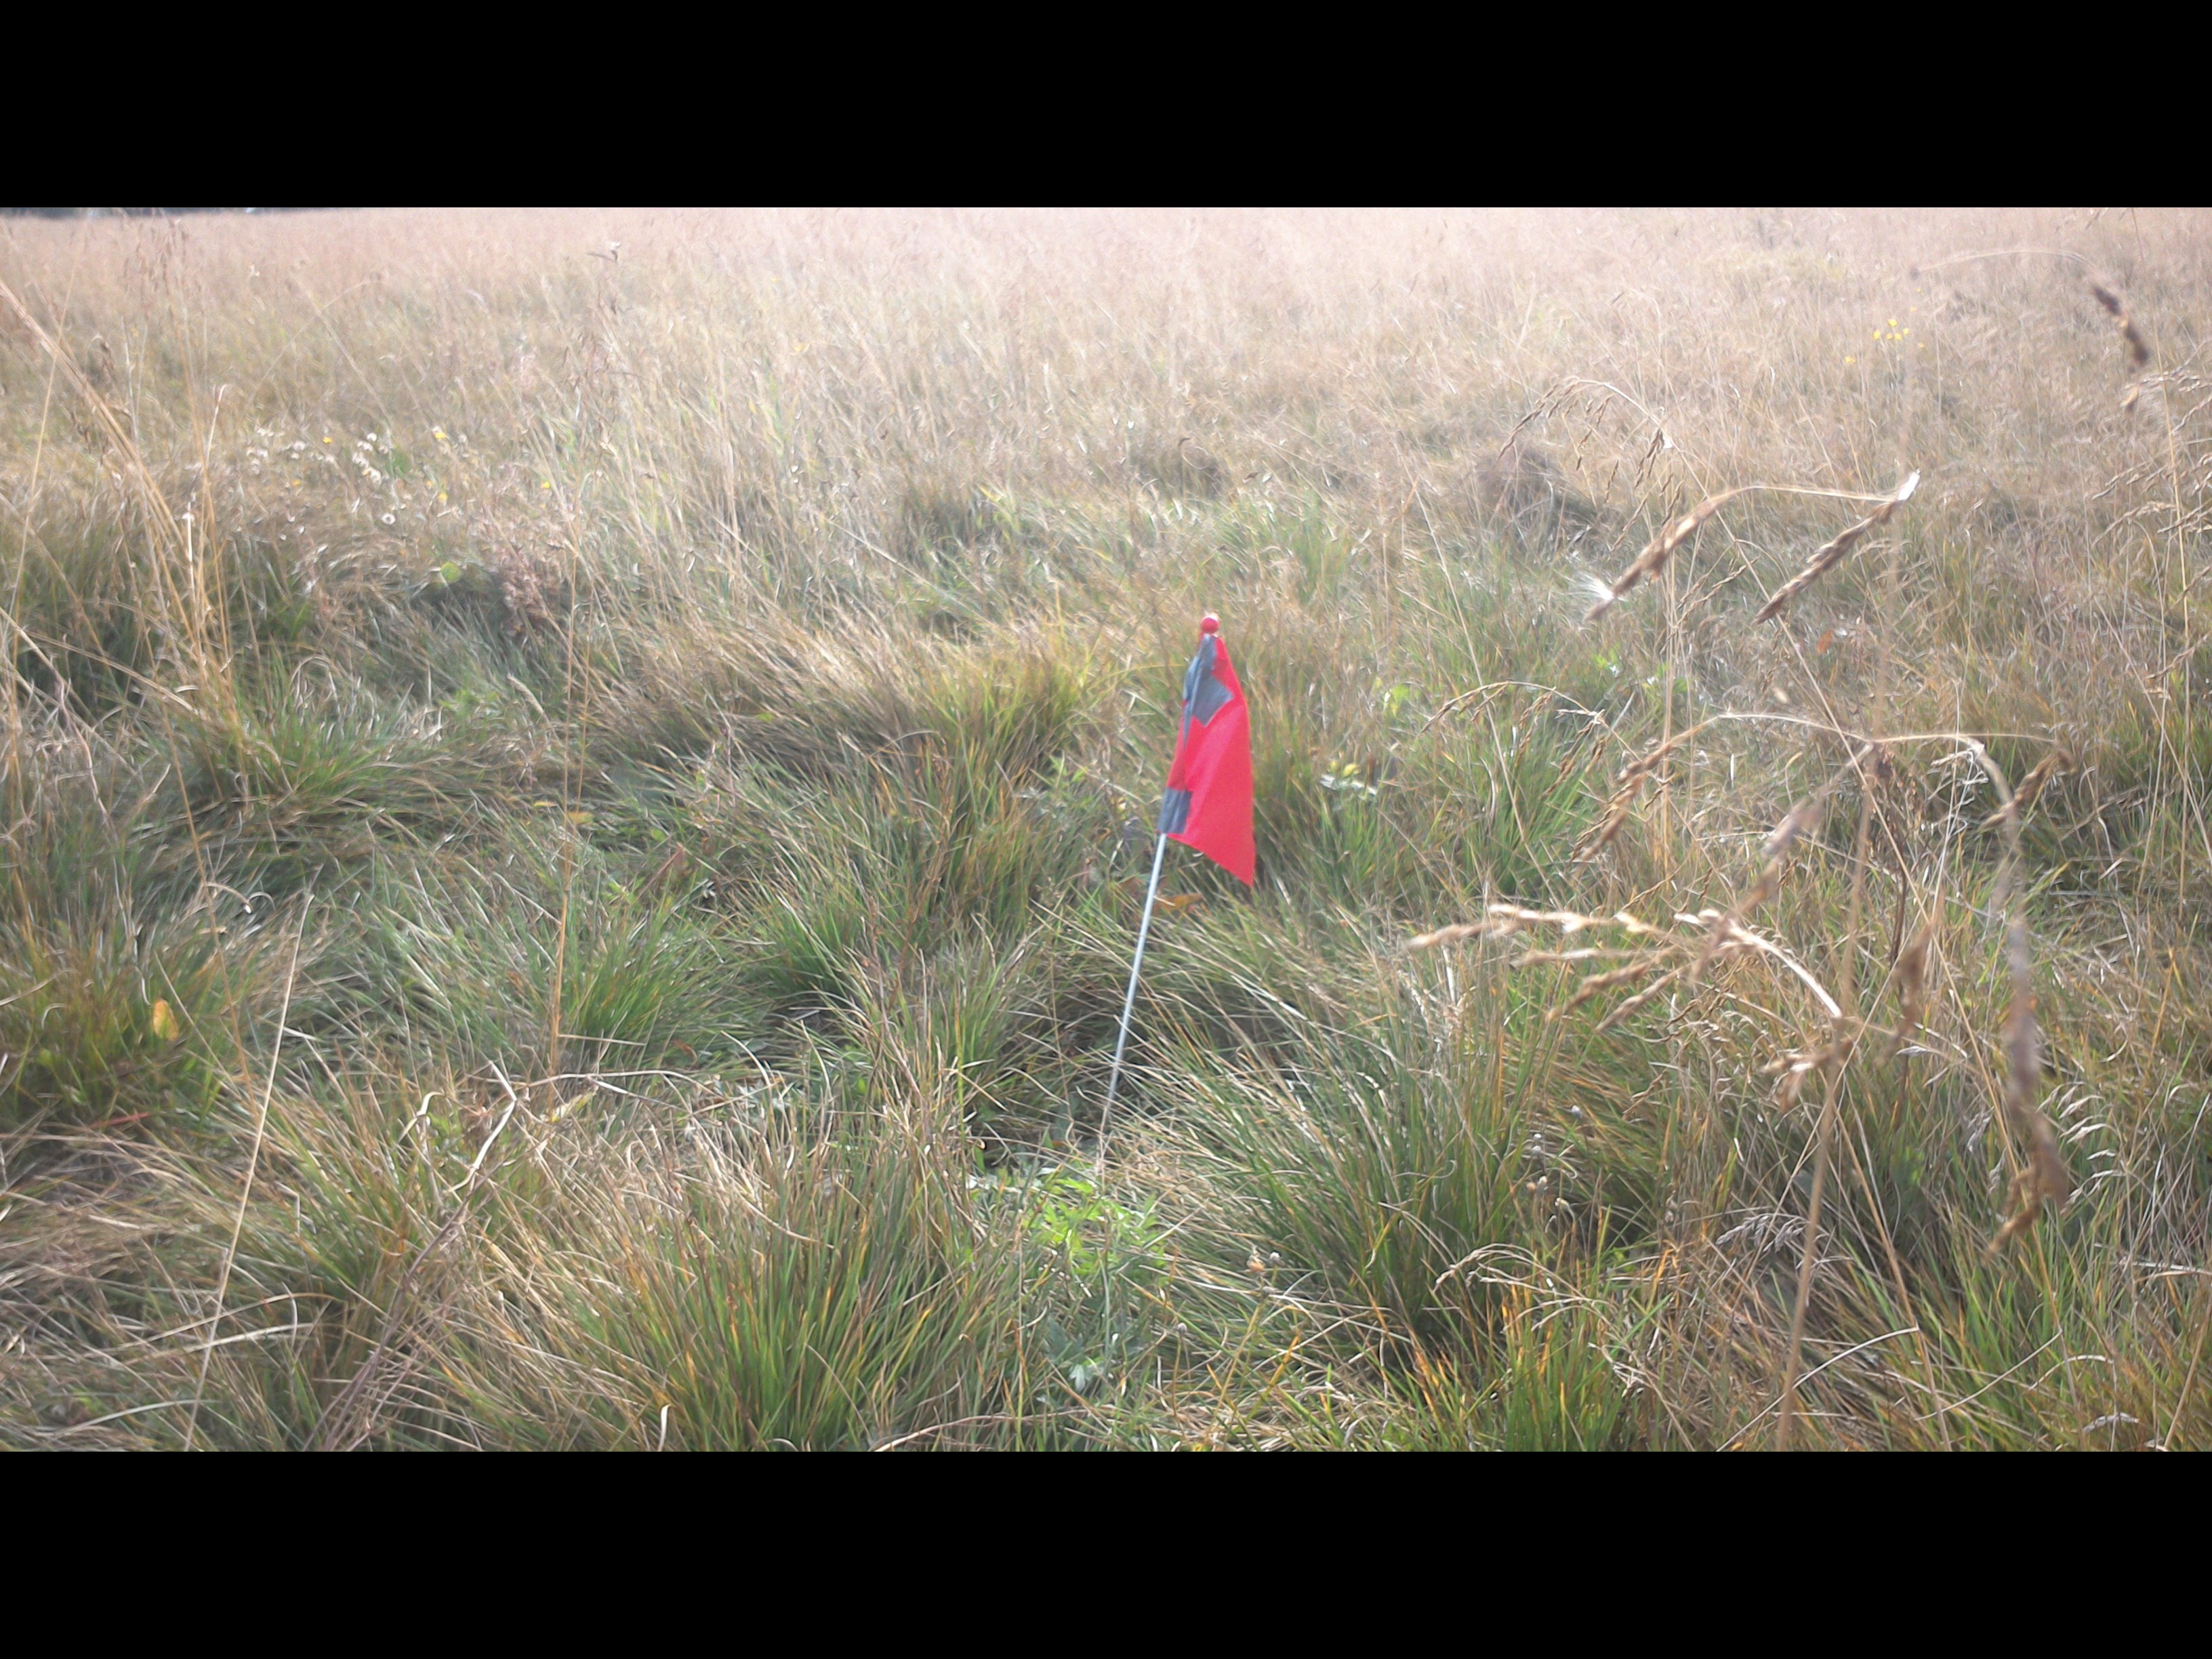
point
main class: Grassland
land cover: Grassland without tree/shrub cover
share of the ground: > 75 %
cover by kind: herbaceous plants 100 %
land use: Agriculture (excluding fallow land and kitchen gardens)
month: September
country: SE
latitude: 63.8064
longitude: 19.7458
